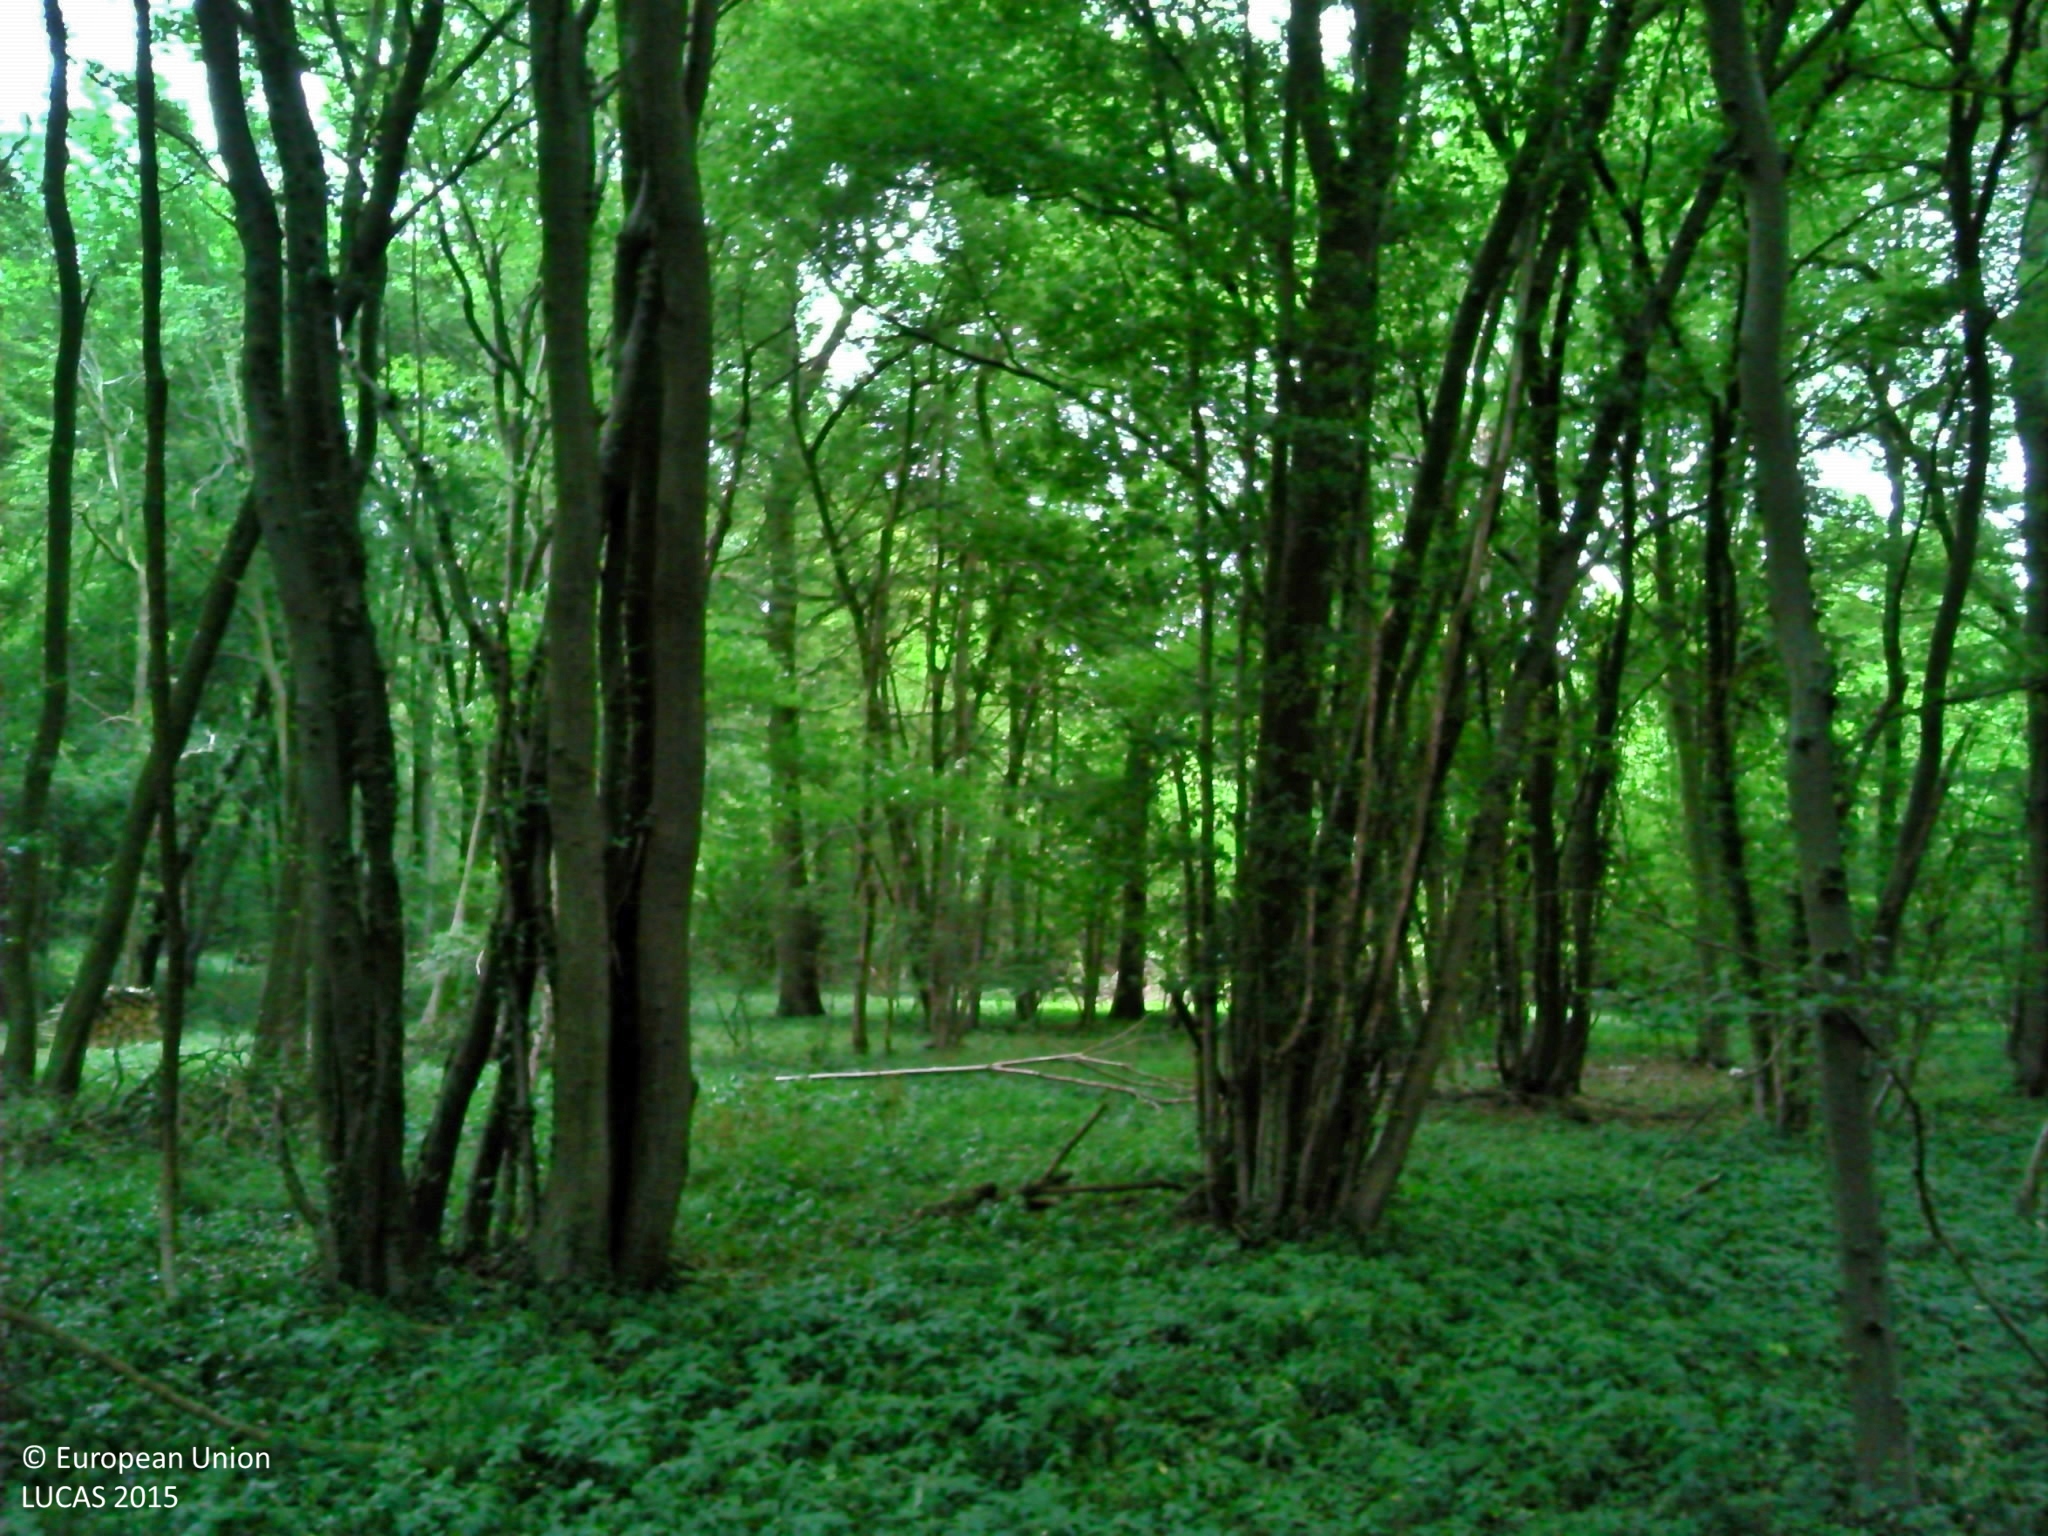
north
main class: Woodland
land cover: Broadleaved woodland
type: acidophilous oak and oak-birch forest
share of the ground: > 75 %
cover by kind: broadleaved forest trees 85 %, herbaceous plants 10 %, shrubs 5 %
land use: Forestry
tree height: > 5 m
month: July
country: FR
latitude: 49.3685
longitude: 2.3720
